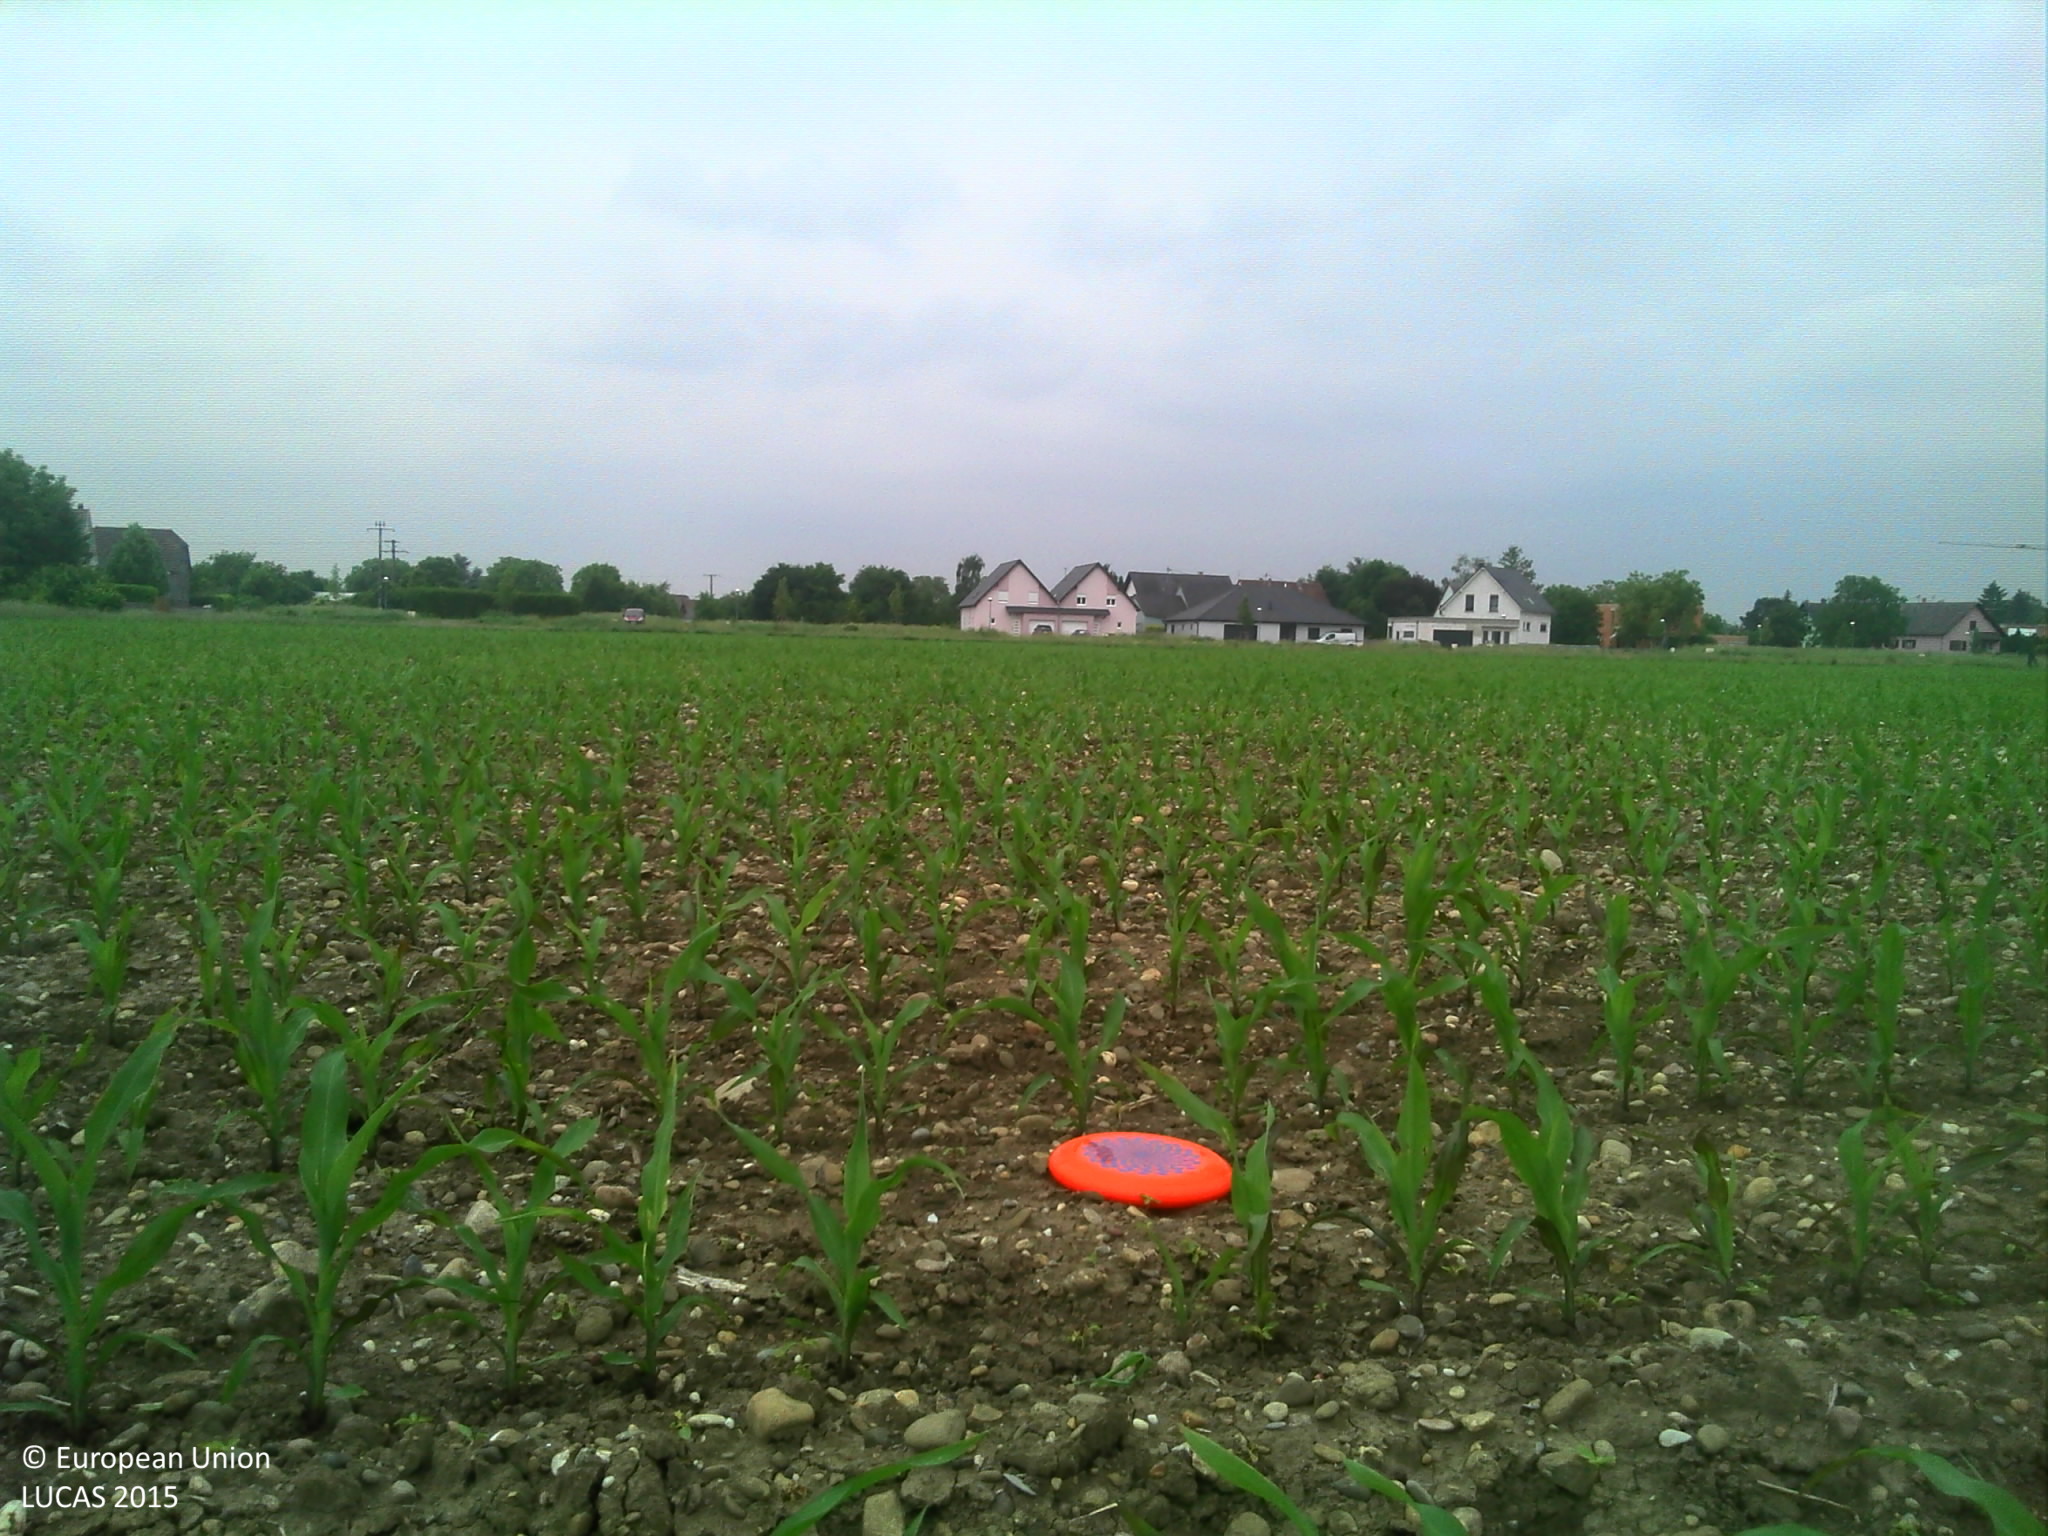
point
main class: Cropland
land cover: Maize
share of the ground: > 75 %
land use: Agriculture (excluding fallow land and kitchen gardens)
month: May
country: FR
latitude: 48.2692
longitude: 7.5894
